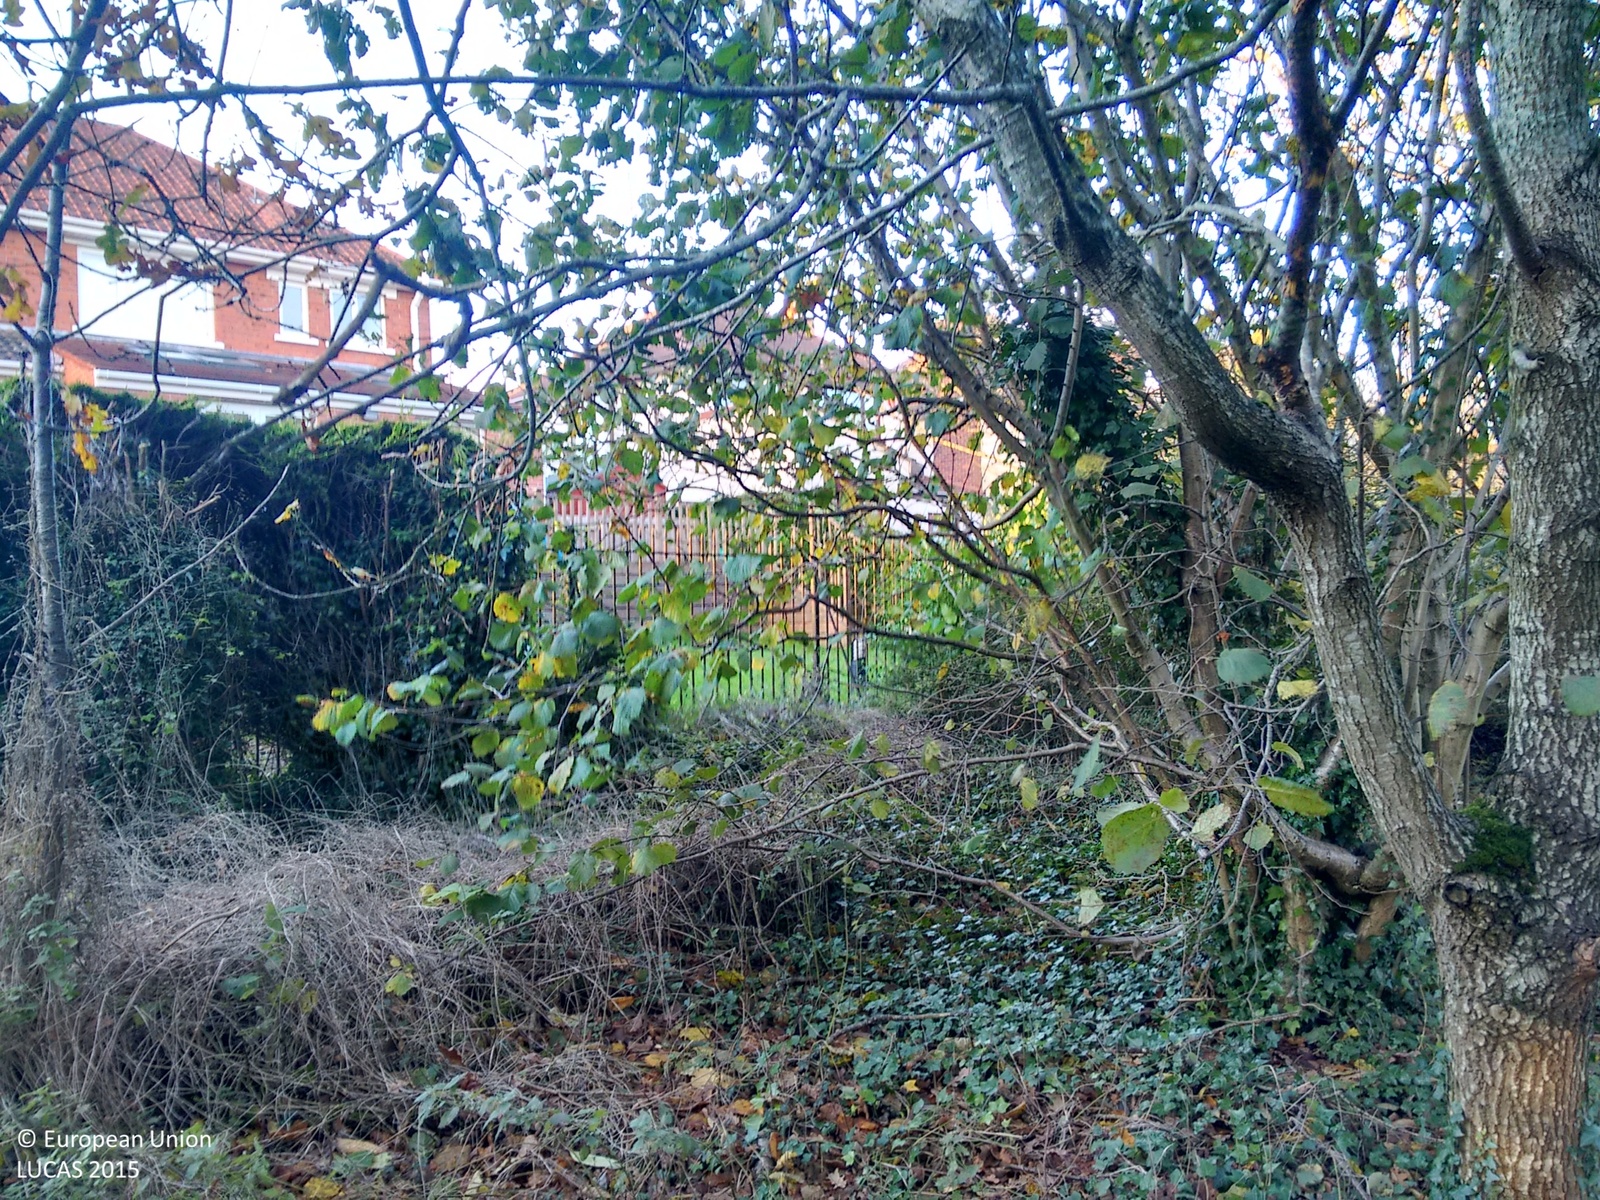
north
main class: Woodland
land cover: Broadleaved woodland
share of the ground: > 75 %
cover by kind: herbaceous plants 40 %, broadleaved forest trees 30 %
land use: Sport
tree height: > 5 m
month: November
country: GB
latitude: 54.6287
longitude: -5.9547
